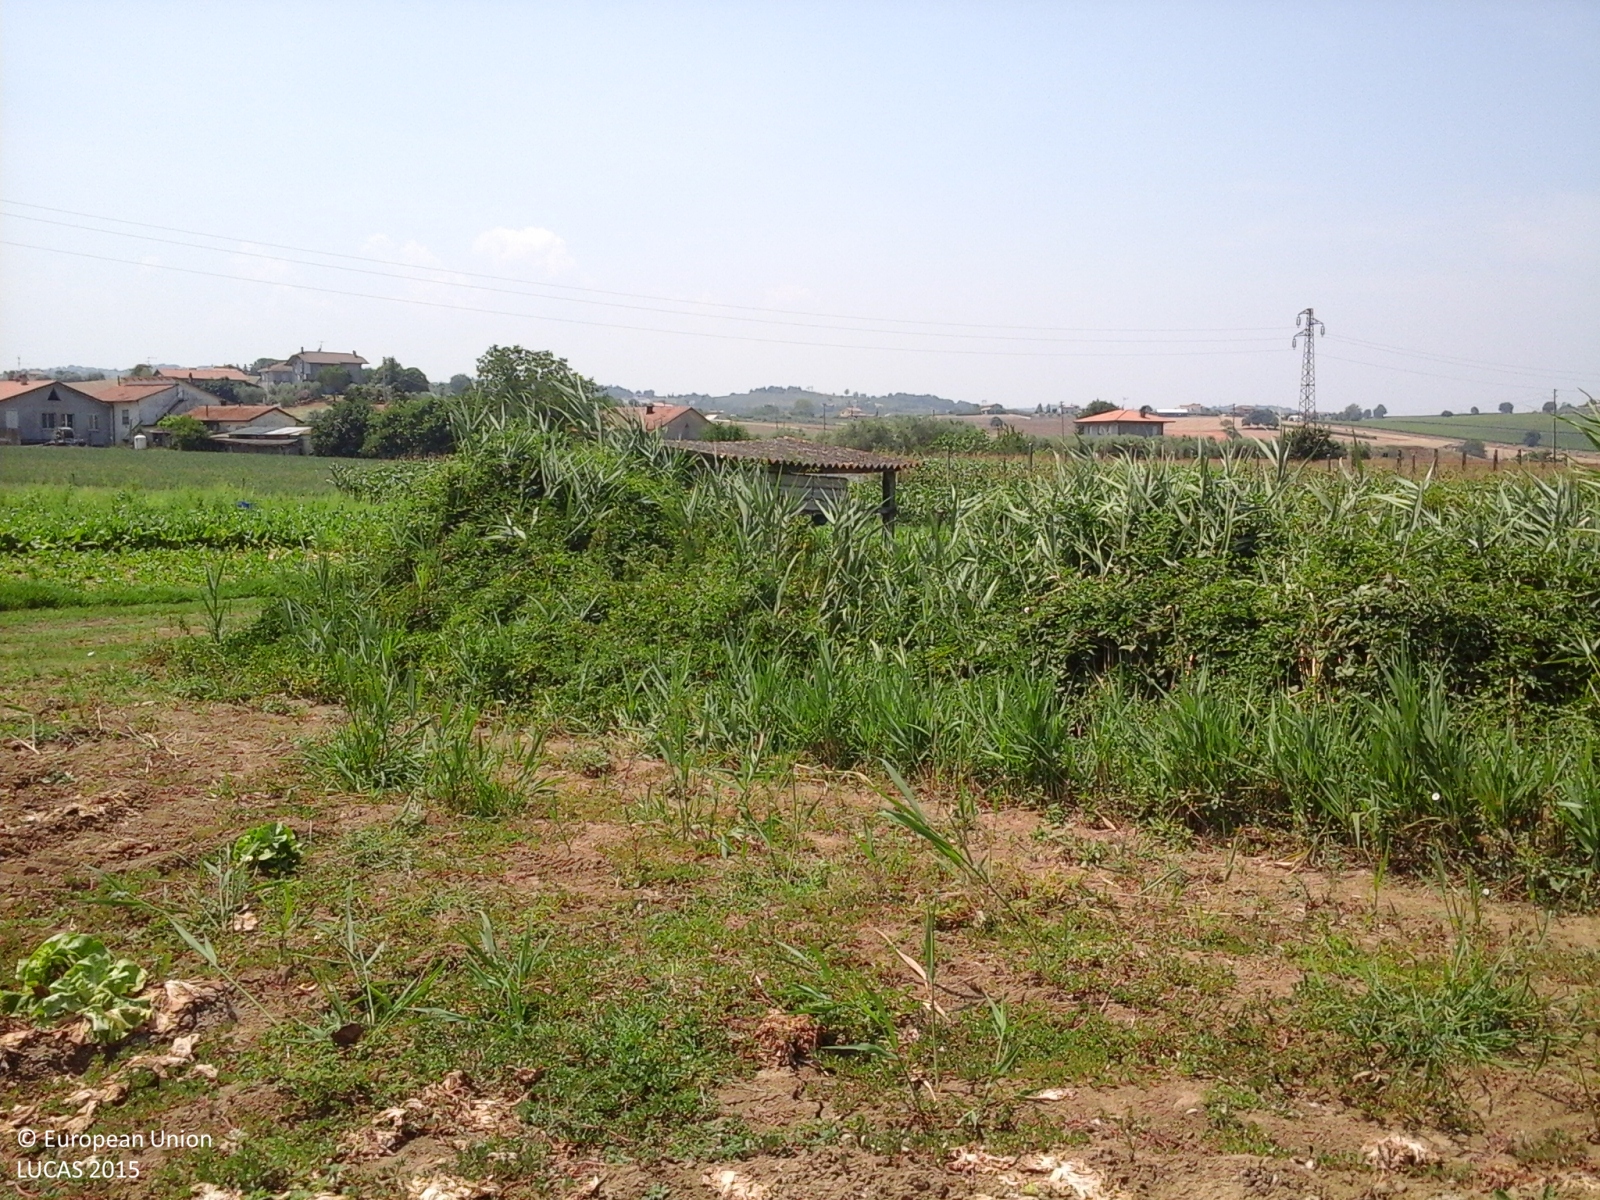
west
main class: Cropland
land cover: Other fresh vegetables
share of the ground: < 10 %
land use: Agriculture (excluding fallow land and kitchen gardens)
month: July
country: IT
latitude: 44.0701
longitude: 12.4042
